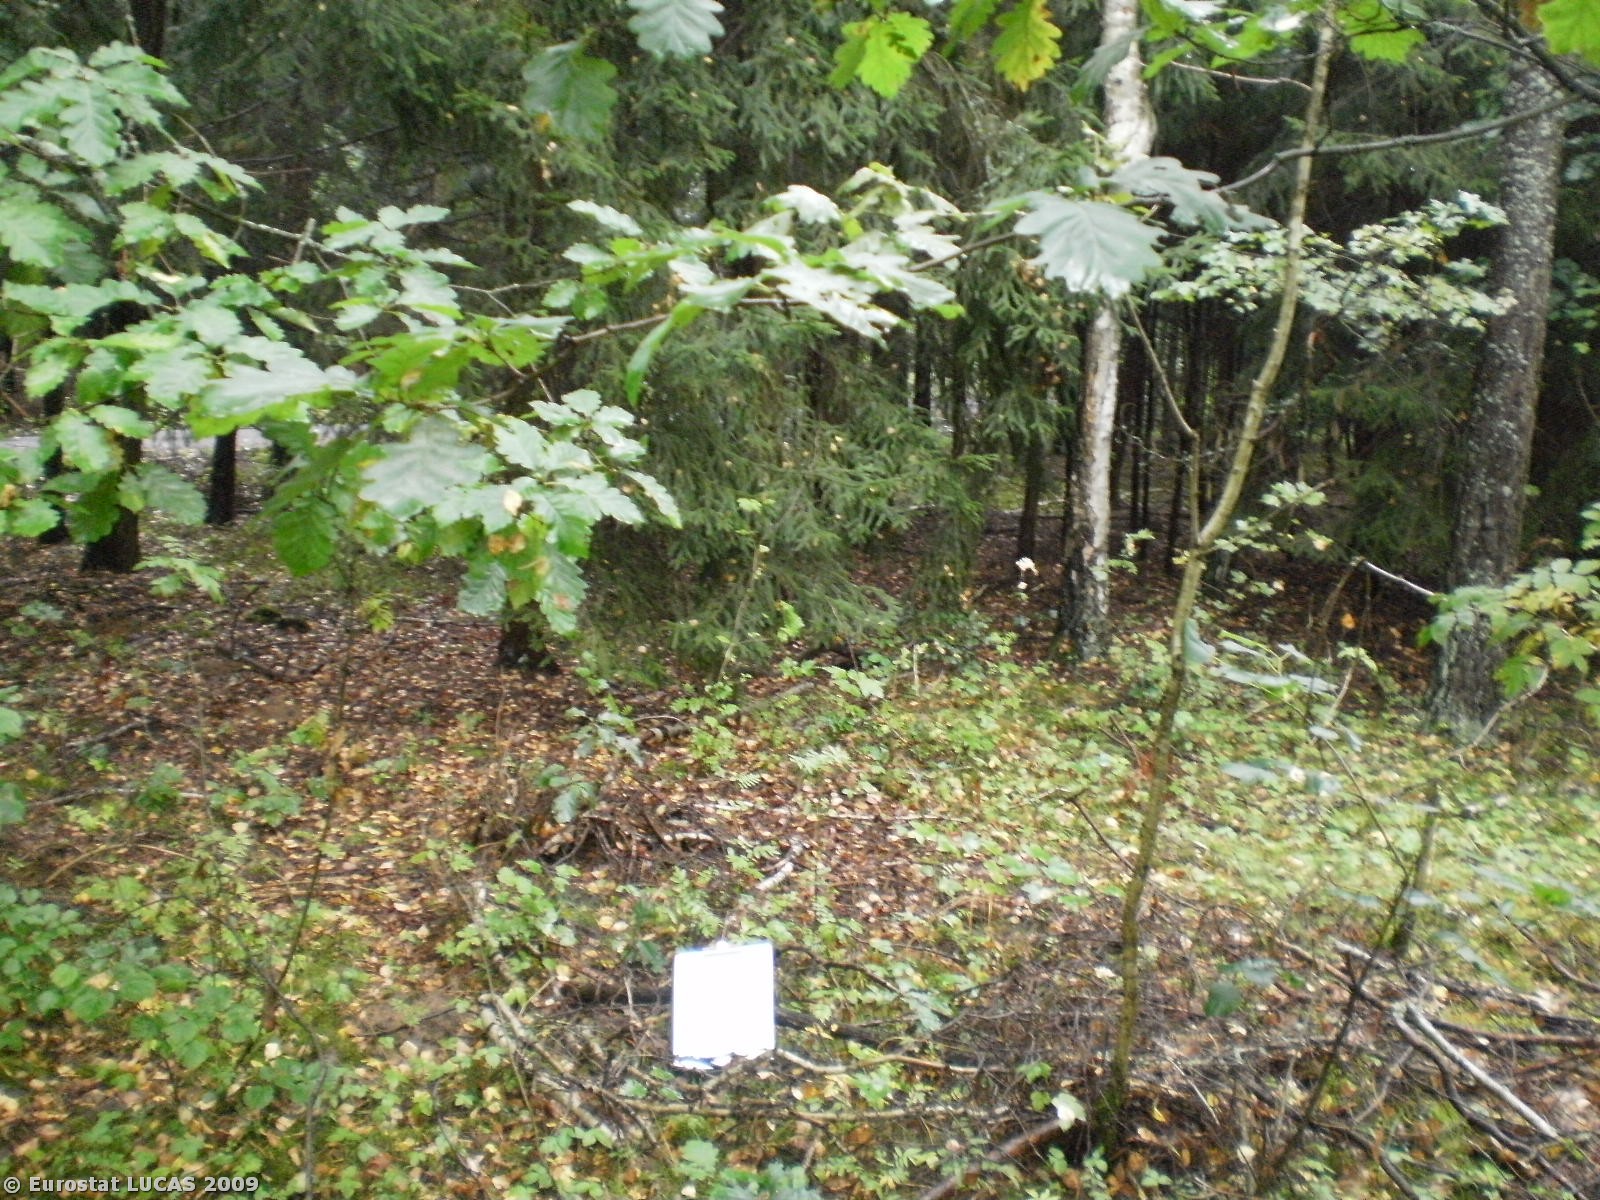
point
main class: Woodland
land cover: Mixed woodland
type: hemiboreal forest and nemoral coniferous forest and mixed broadleaved-coniferous forest
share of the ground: > 75 %
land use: Forestry
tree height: > 5 m
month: September
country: PL
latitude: 53.7506
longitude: 17.7318
